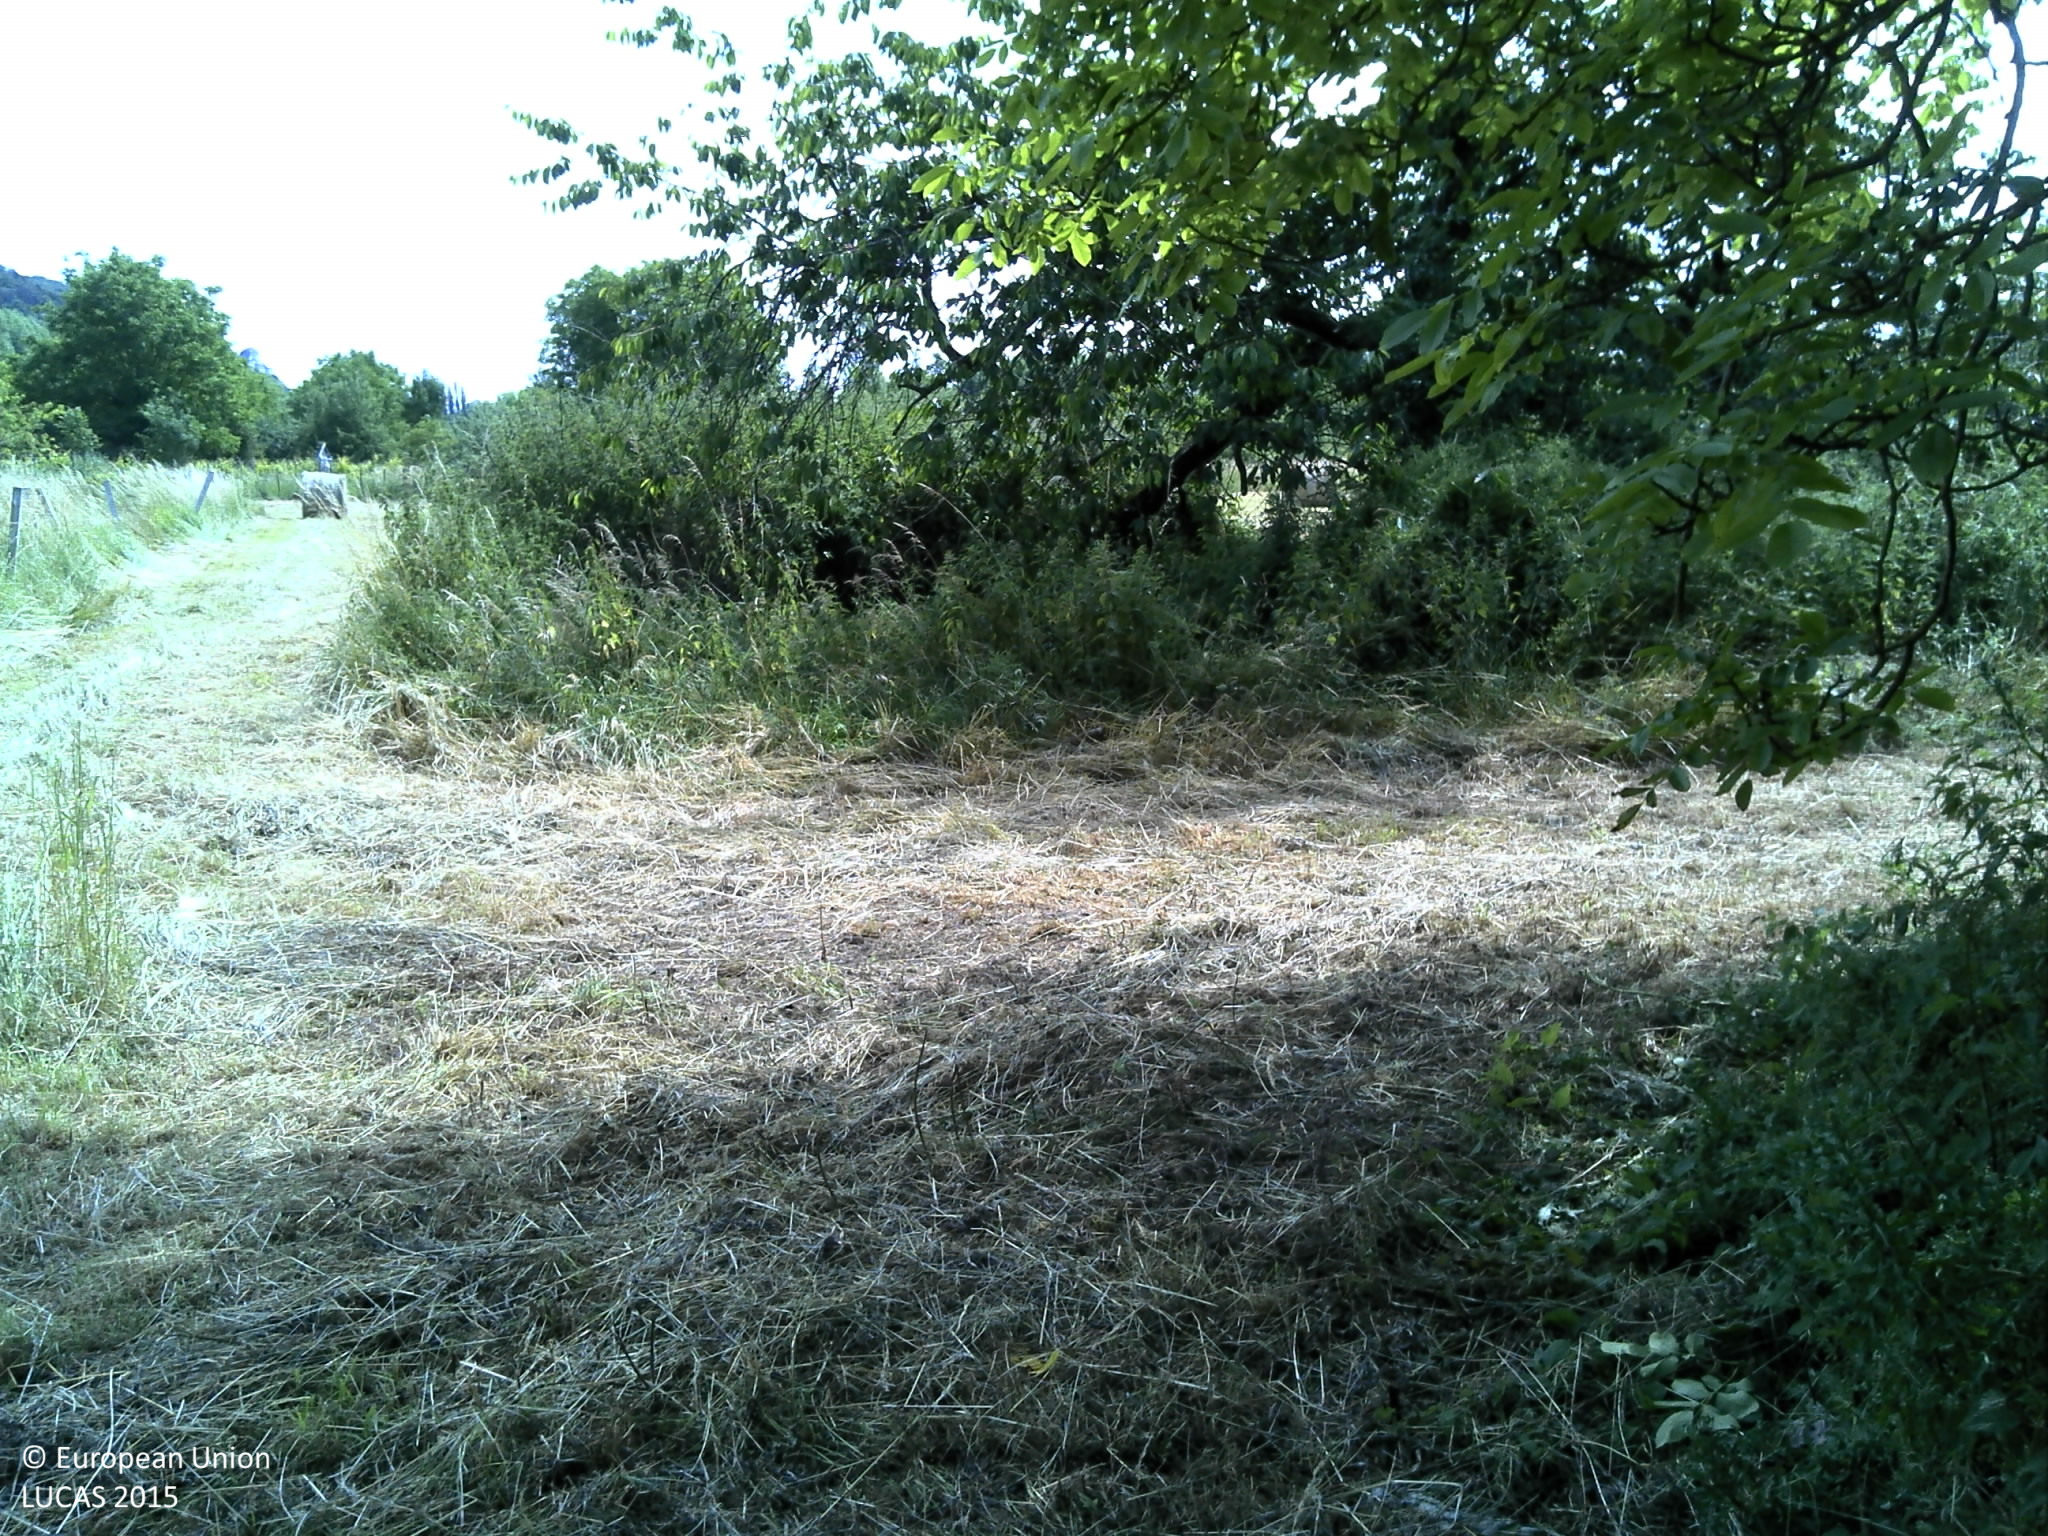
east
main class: Cropland
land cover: Nuts trees
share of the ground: 50 - 75 %
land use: Agriculture (excluding fallow land and kitchen gardens)
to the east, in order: Nuts trees; Grassland without tree/shrub cover; Fences; Apple fruit; Spontaneously vegetated surfaces; Fences; Lines of trees; Fences; Grassland without tree/shrub cover; Grassland with sparse tree/shrub cover; Fences; Other fresh vegetables; Lines of trees; Grassland without tree/shrub cover
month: June
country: FR
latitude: 49.3227
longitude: 1.0215
